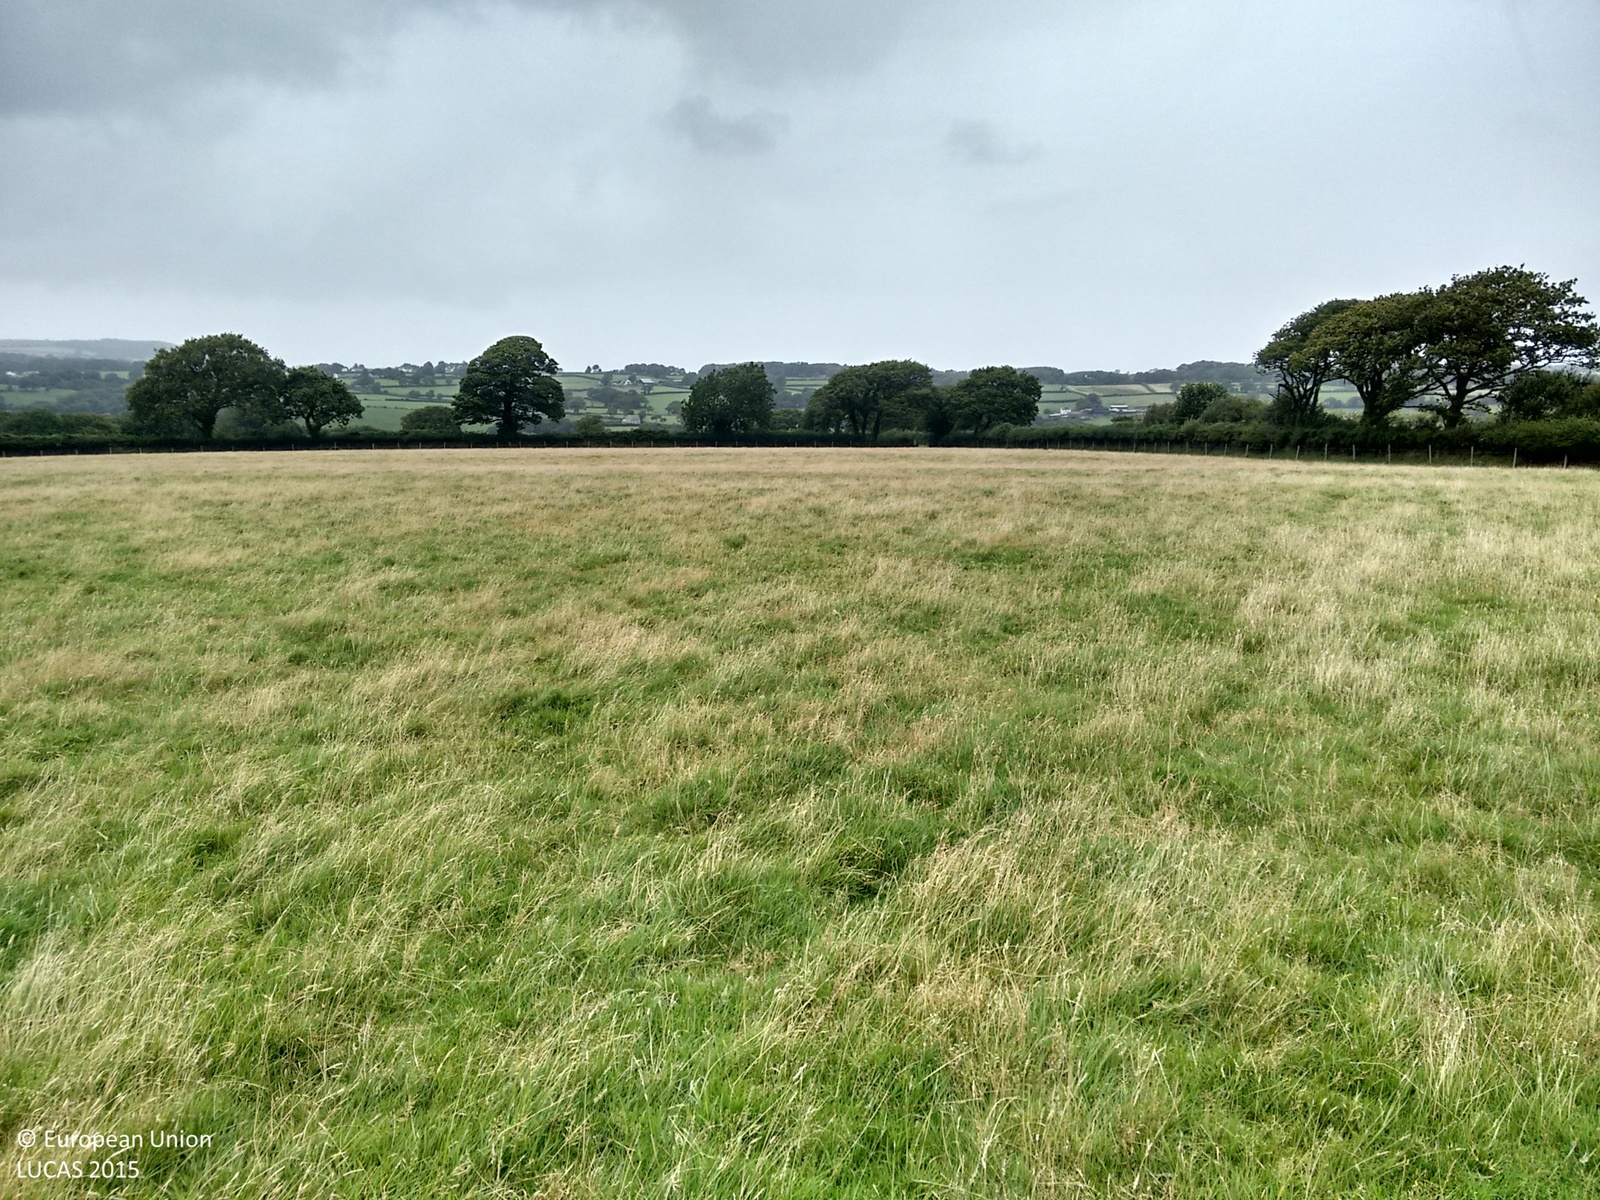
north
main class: Grassland
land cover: Grassland without tree/shrub cover
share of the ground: > 75 %
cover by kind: herbaceous plants 100 %
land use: Agriculture (excluding fallow land and kitchen gardens)
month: August
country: GB
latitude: 51.9983
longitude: -4.6002
